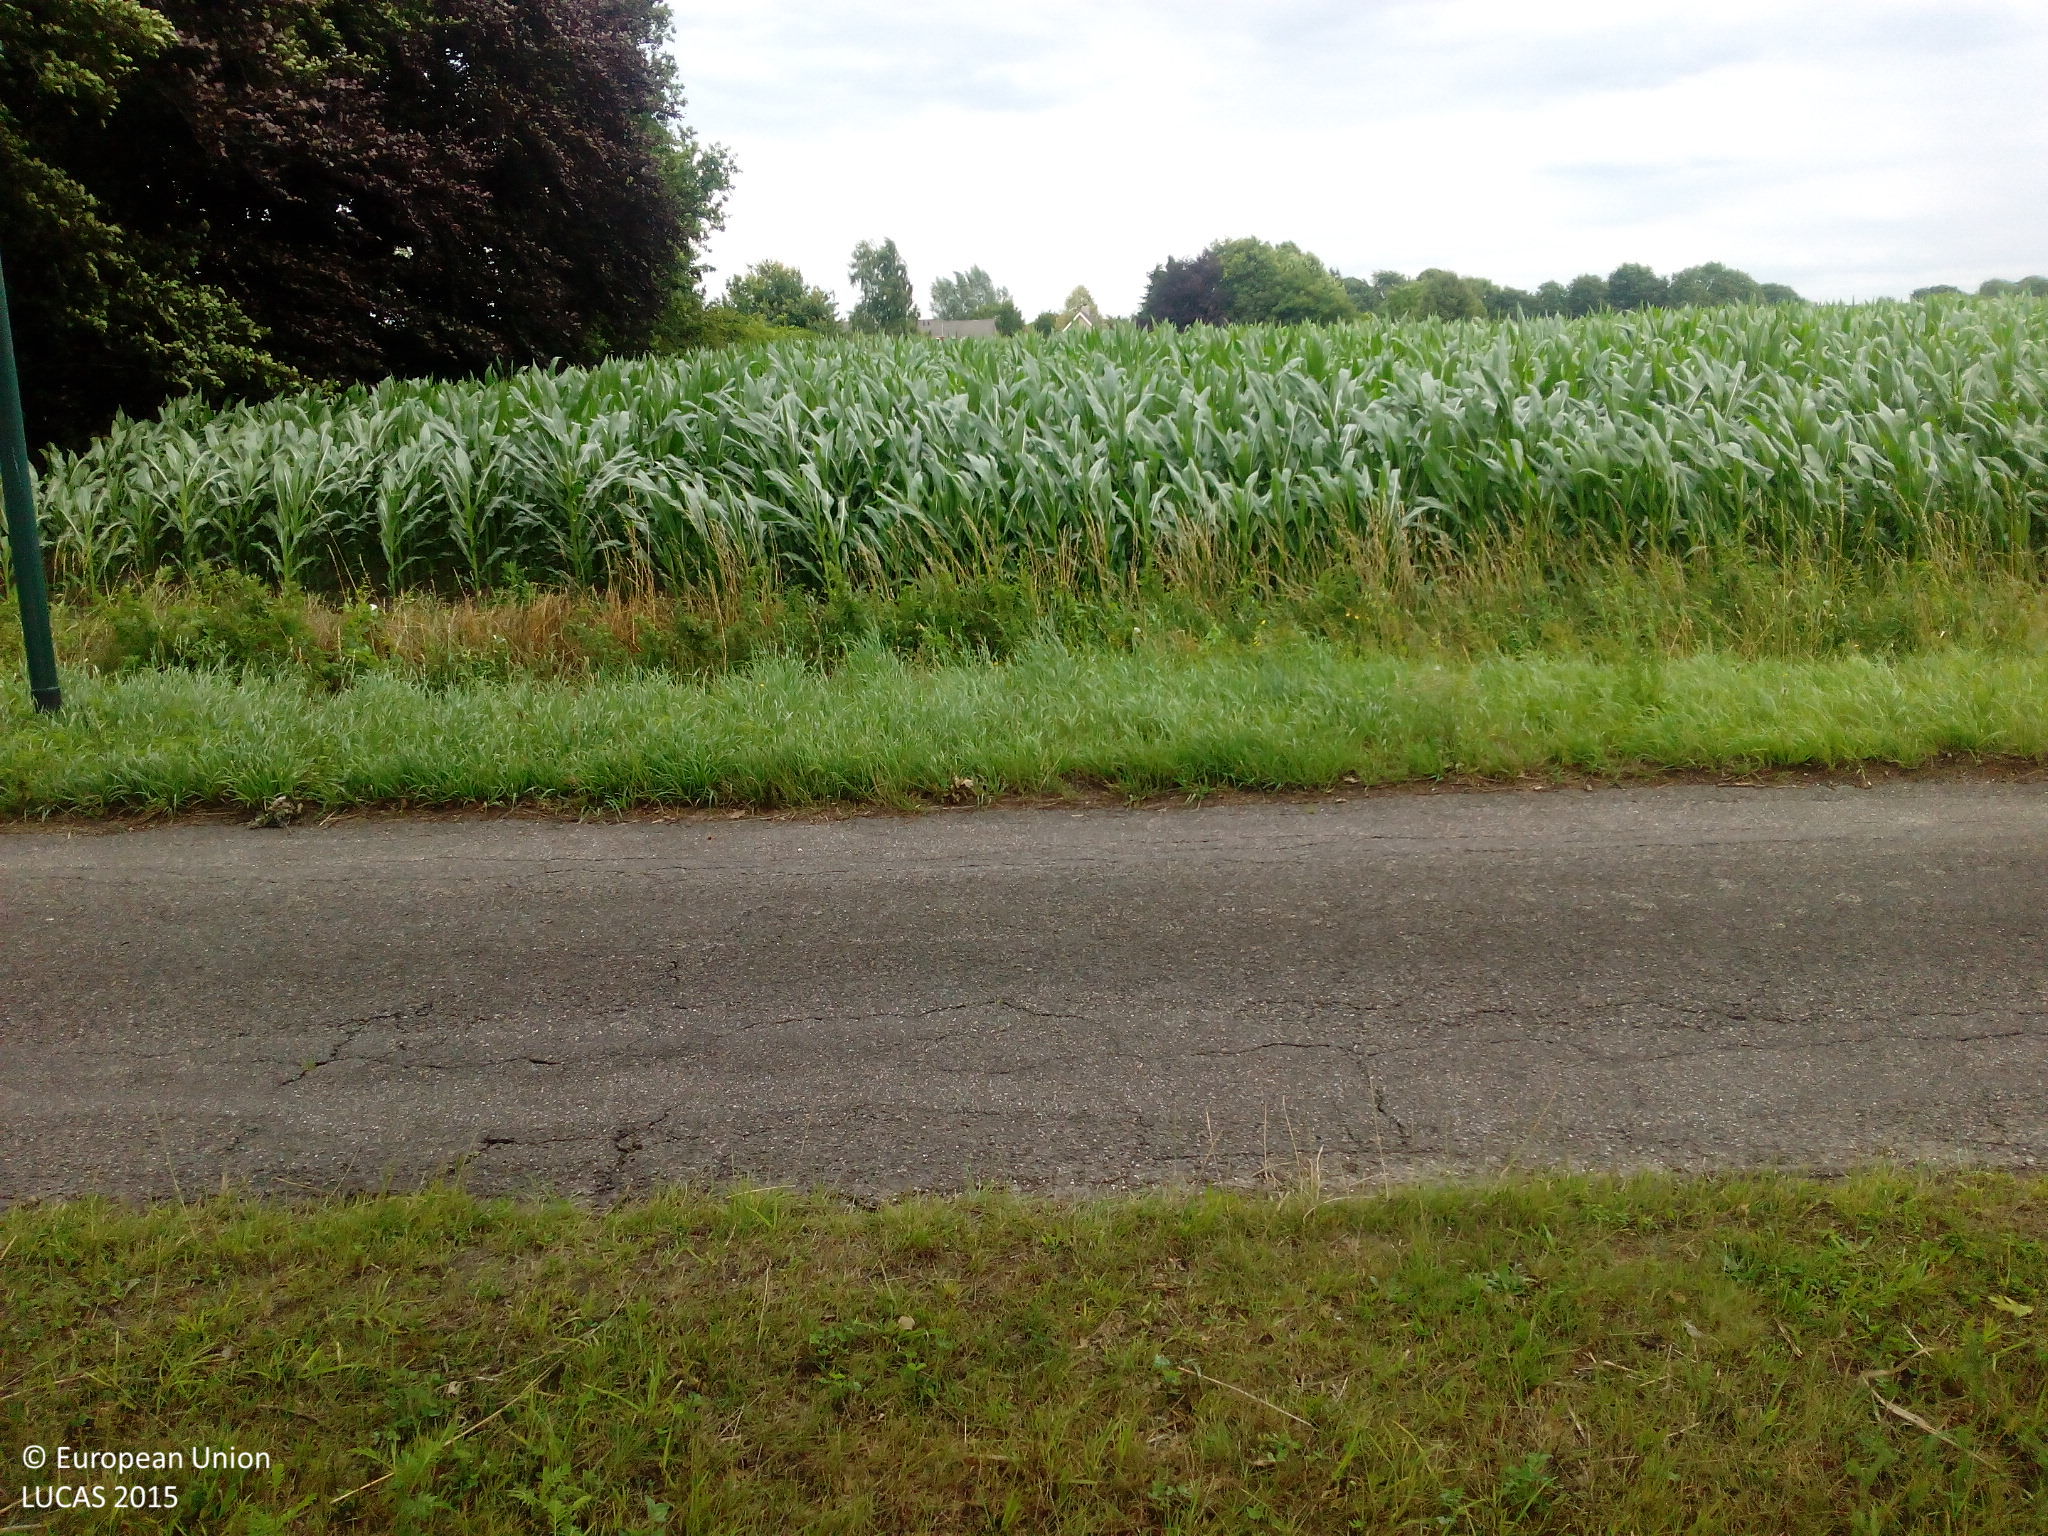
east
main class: Grassland
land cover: Grassland without tree/shrub cover
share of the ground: > 75 %
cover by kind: herbaceous plants 100 %
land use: Amenities, museums, leisure
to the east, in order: Grassland without tree/shrub cover; Fences; Ditches and canals; Grass margins; Lines of trees; Grass margins; Paved roads, cycling and walking lanes; Grass margins; Ditches and canals; Grass margins; Maize; Grass margins; Ditches and canals; Artificial constructions in urban areas
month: July
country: NL
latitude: 51.5925
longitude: 4.6988
